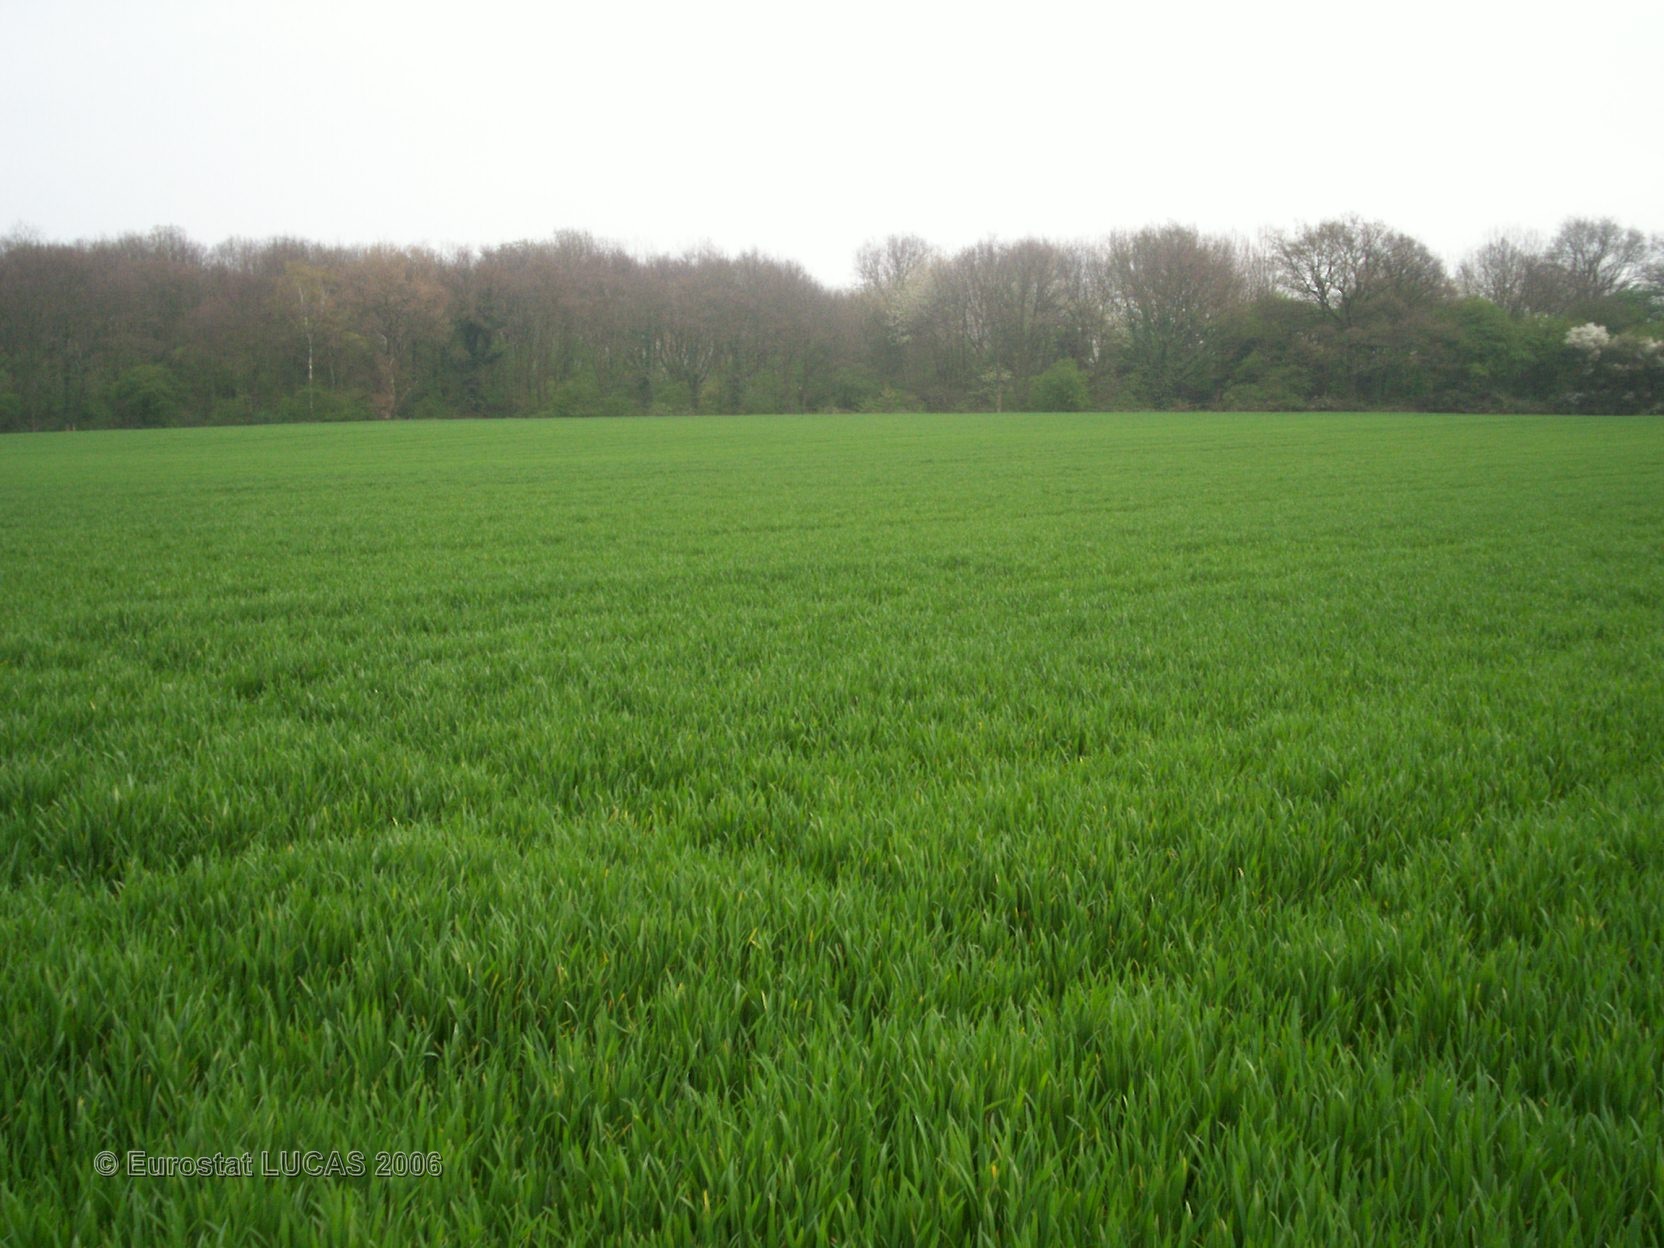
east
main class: Cropland
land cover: Common wheat
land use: Agriculture (excluding fallow land and kitchen gardens)
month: April
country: FR
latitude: 50.5204
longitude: 2.5830
